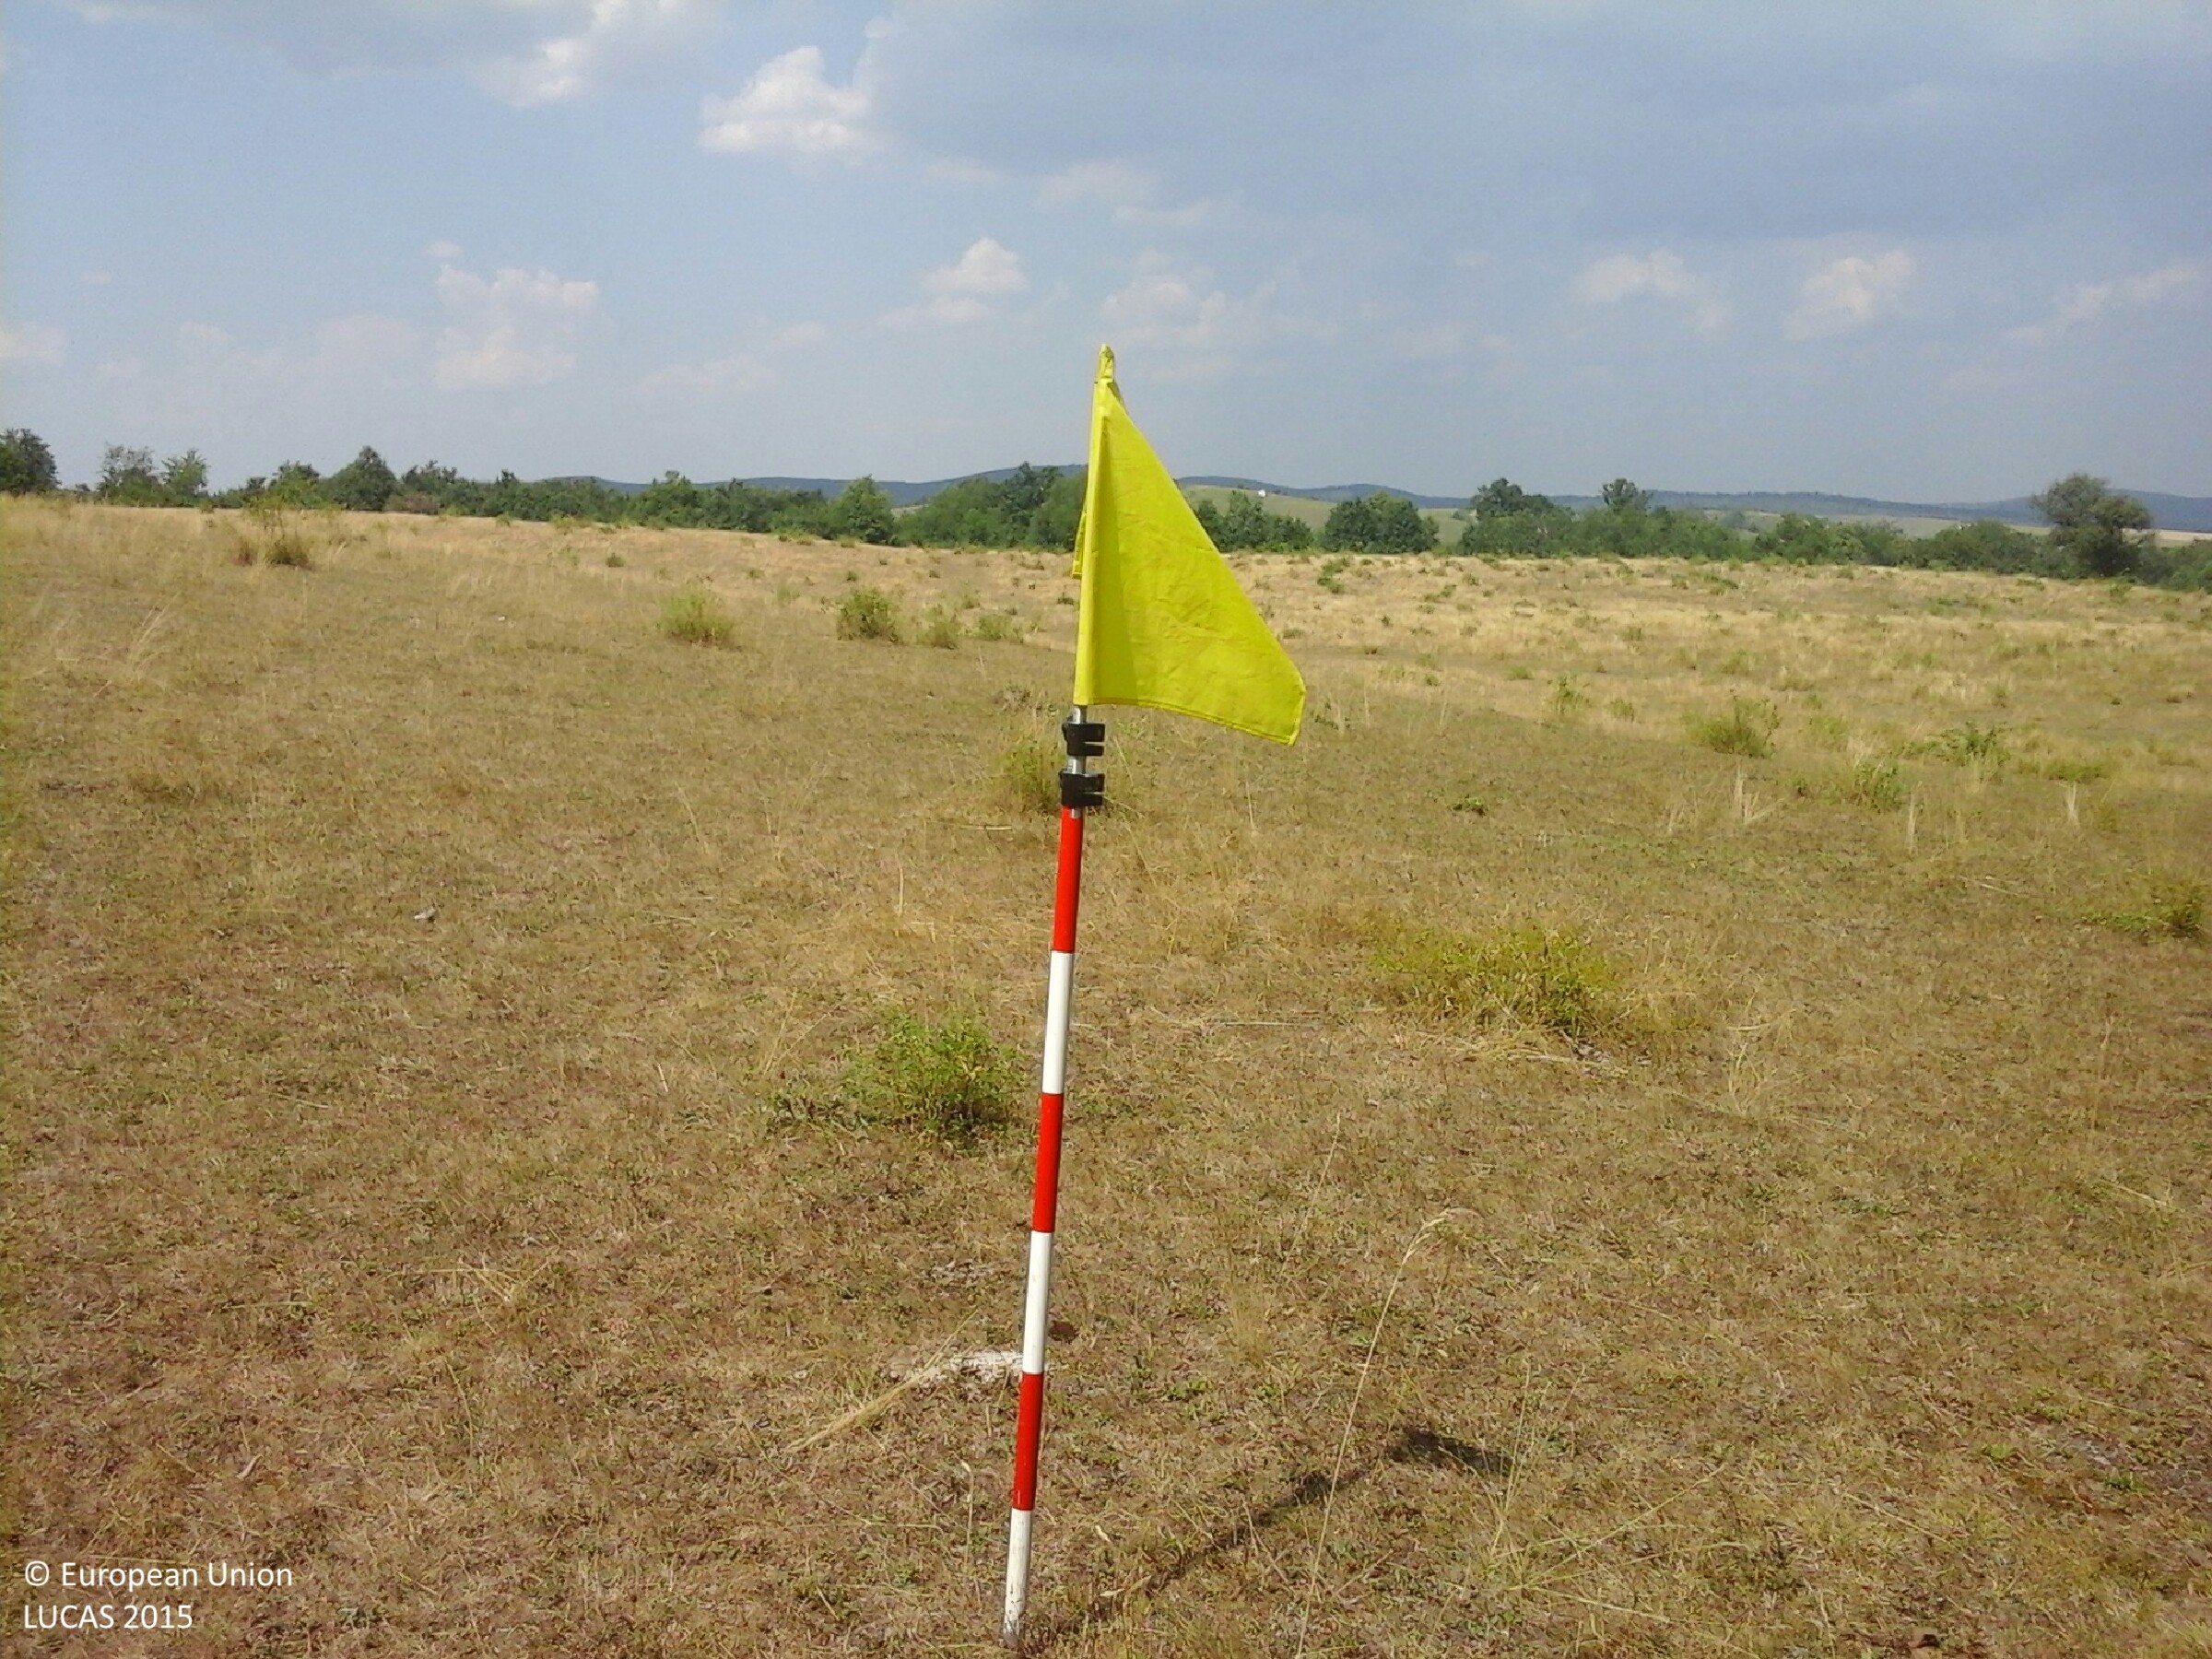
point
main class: Grassland
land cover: Grassland with sparse tree/shrub cover
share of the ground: > 75 %
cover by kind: herbaceous plants 95 %, broadleaved forest trees 5 %
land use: Agriculture (excluding fallow land and kitchen gardens)
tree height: > 5 m
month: July
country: HU
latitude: 48.1427
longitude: 20.6391
